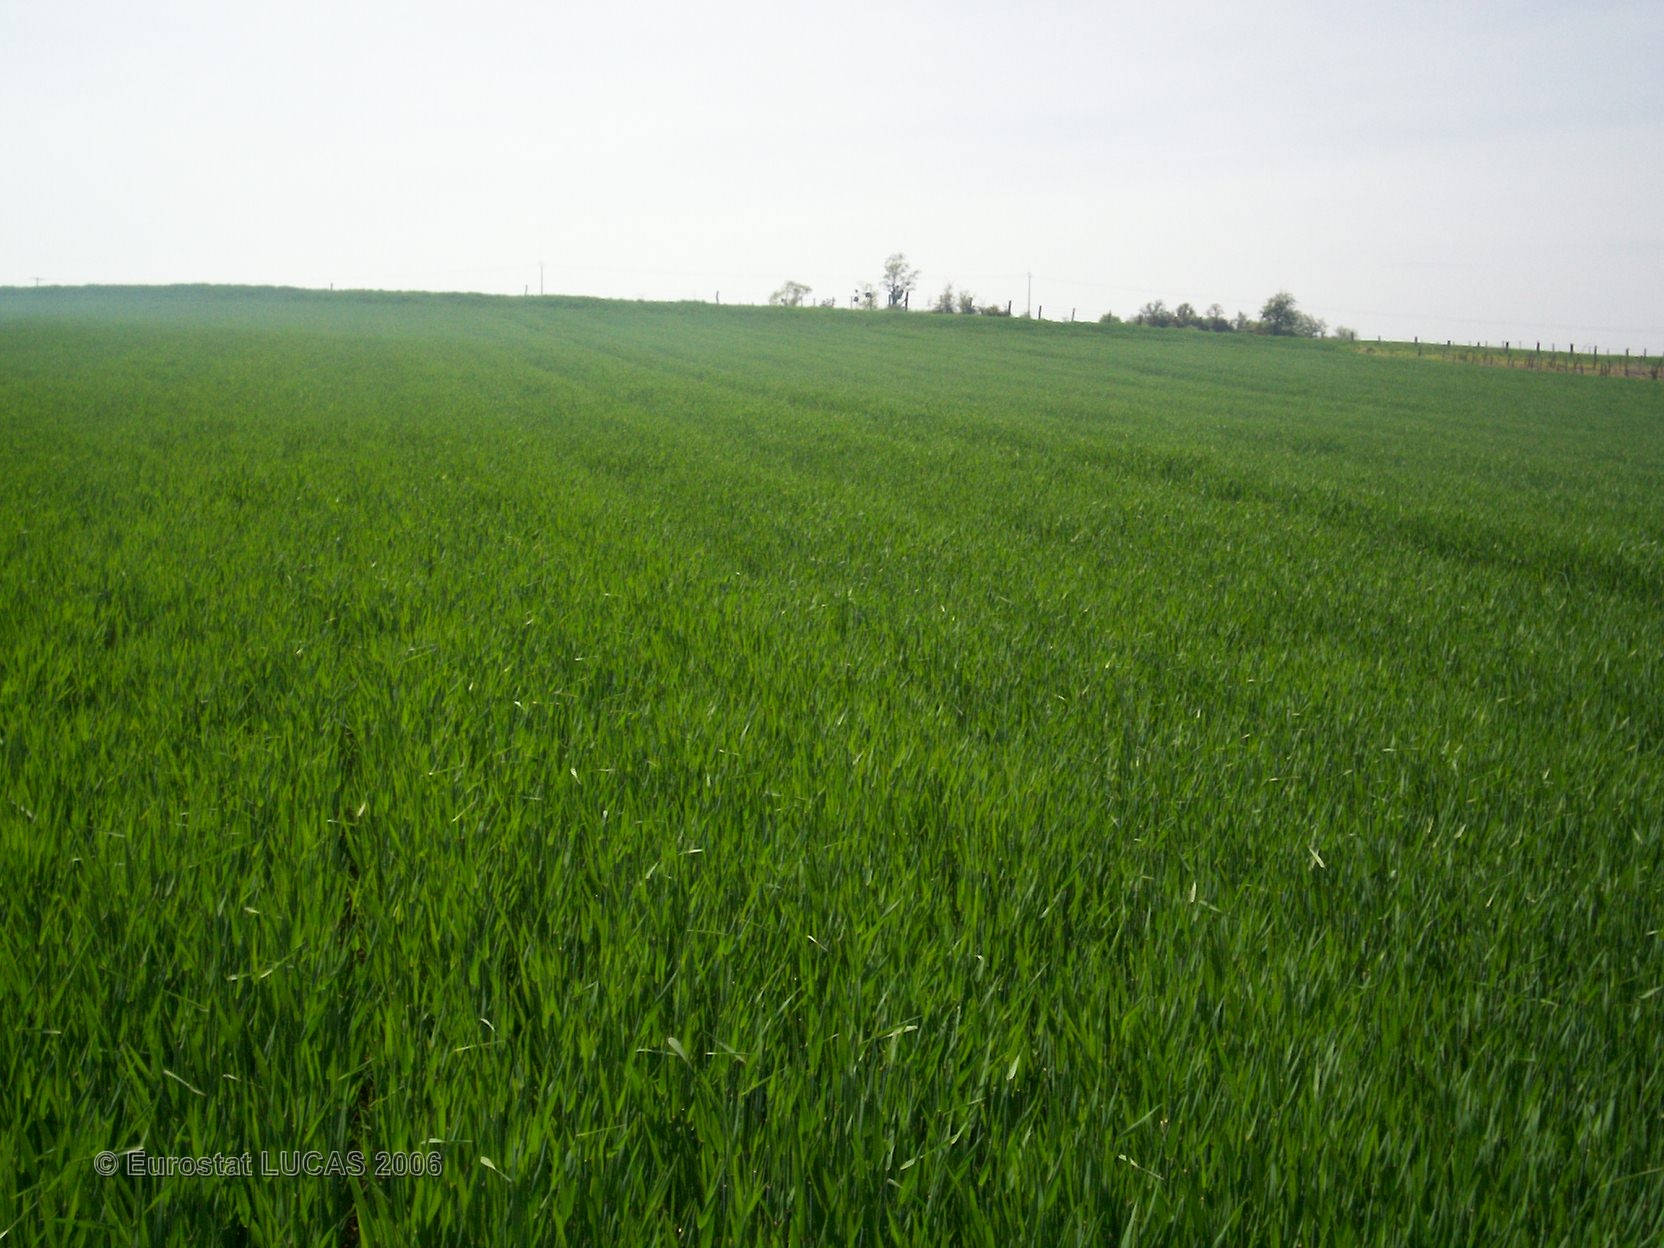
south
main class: Cropland
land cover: Barley
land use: Agriculture (excluding fallow land and kitchen gardens)
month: May
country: FR
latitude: 47.9719
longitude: 4.0359
